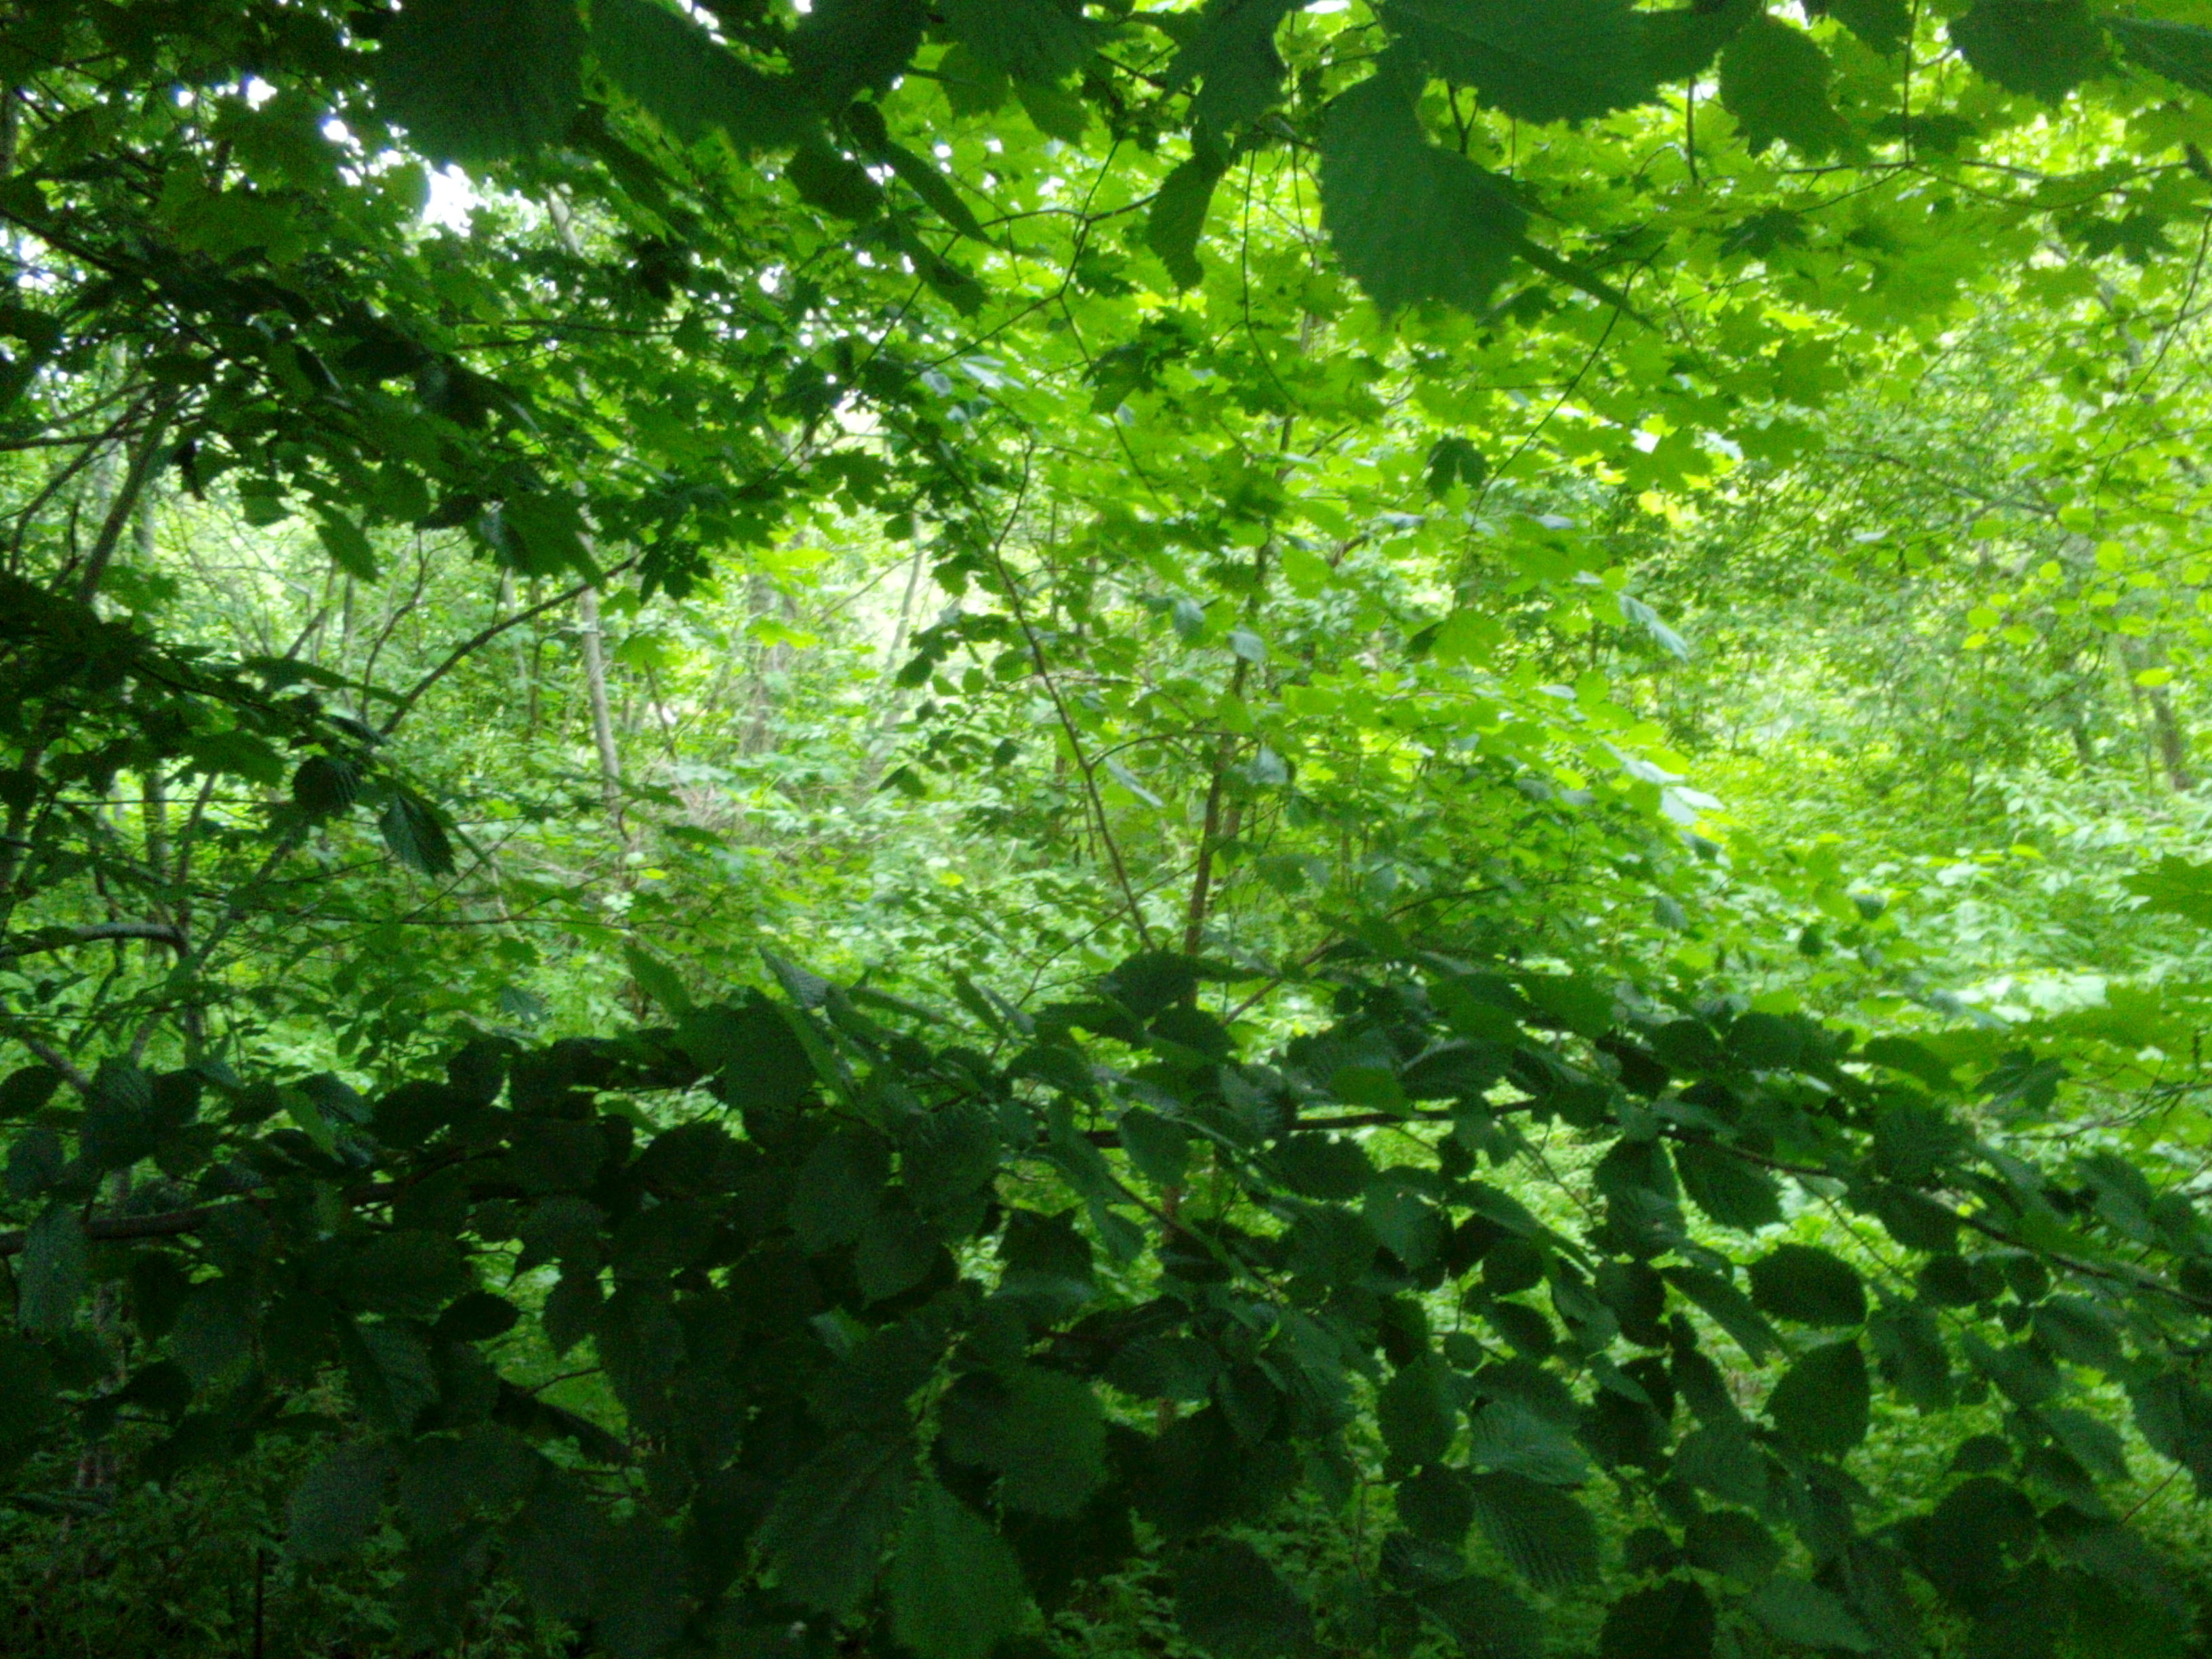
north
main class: Woodland
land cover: Broadleaved woodland
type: non-riverine alder, birch or aspen forest
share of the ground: > 75 %
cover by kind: broadleaved forest trees 80 %, shrubs 10 %, herbaceous plants 10 %
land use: Forestry
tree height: > 5 m
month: June
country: LV
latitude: 56.8450
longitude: 21.7667
